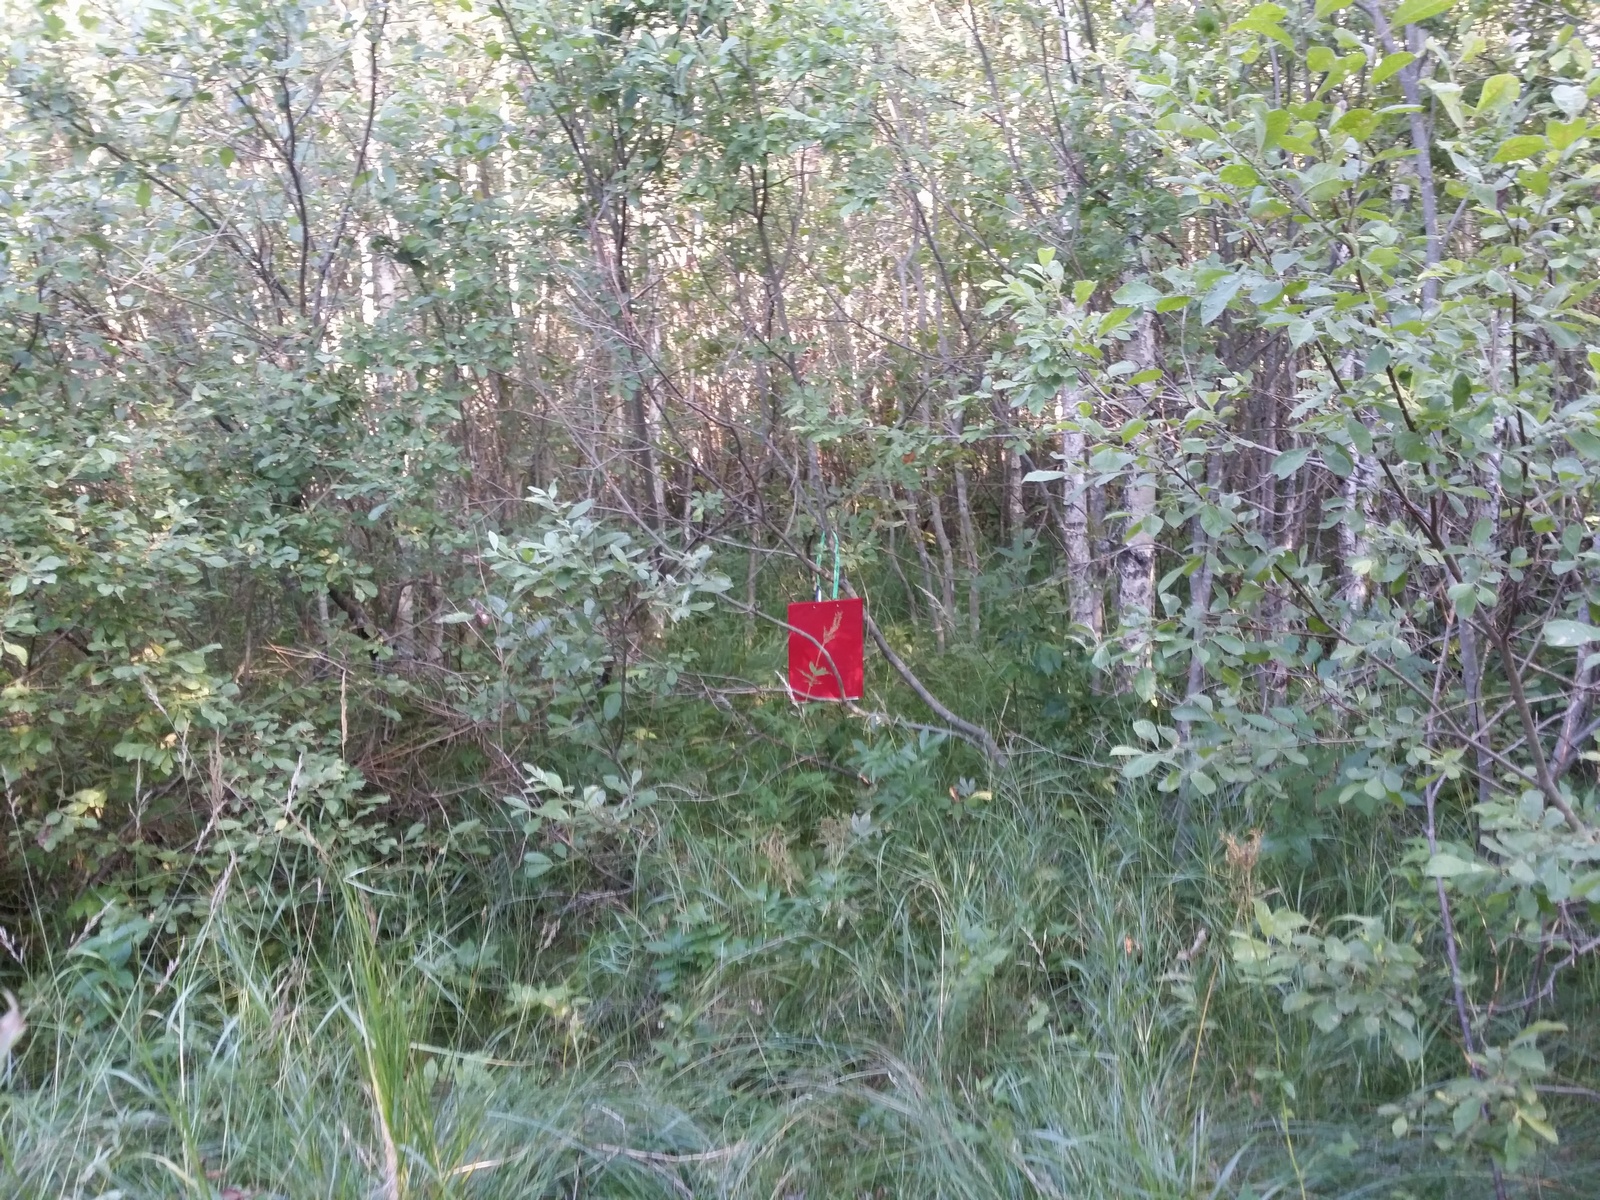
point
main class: Woodland
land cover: Broadleaved woodland
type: non-riverine alder, birch or aspen forest
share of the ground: > 75 %
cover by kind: broadleaved forest trees 85 %, shrubs 10 %, herbaceous plants 5 %
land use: Forestry
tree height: > 5 m
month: August
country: LV
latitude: 57.5934
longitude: 26.9354
